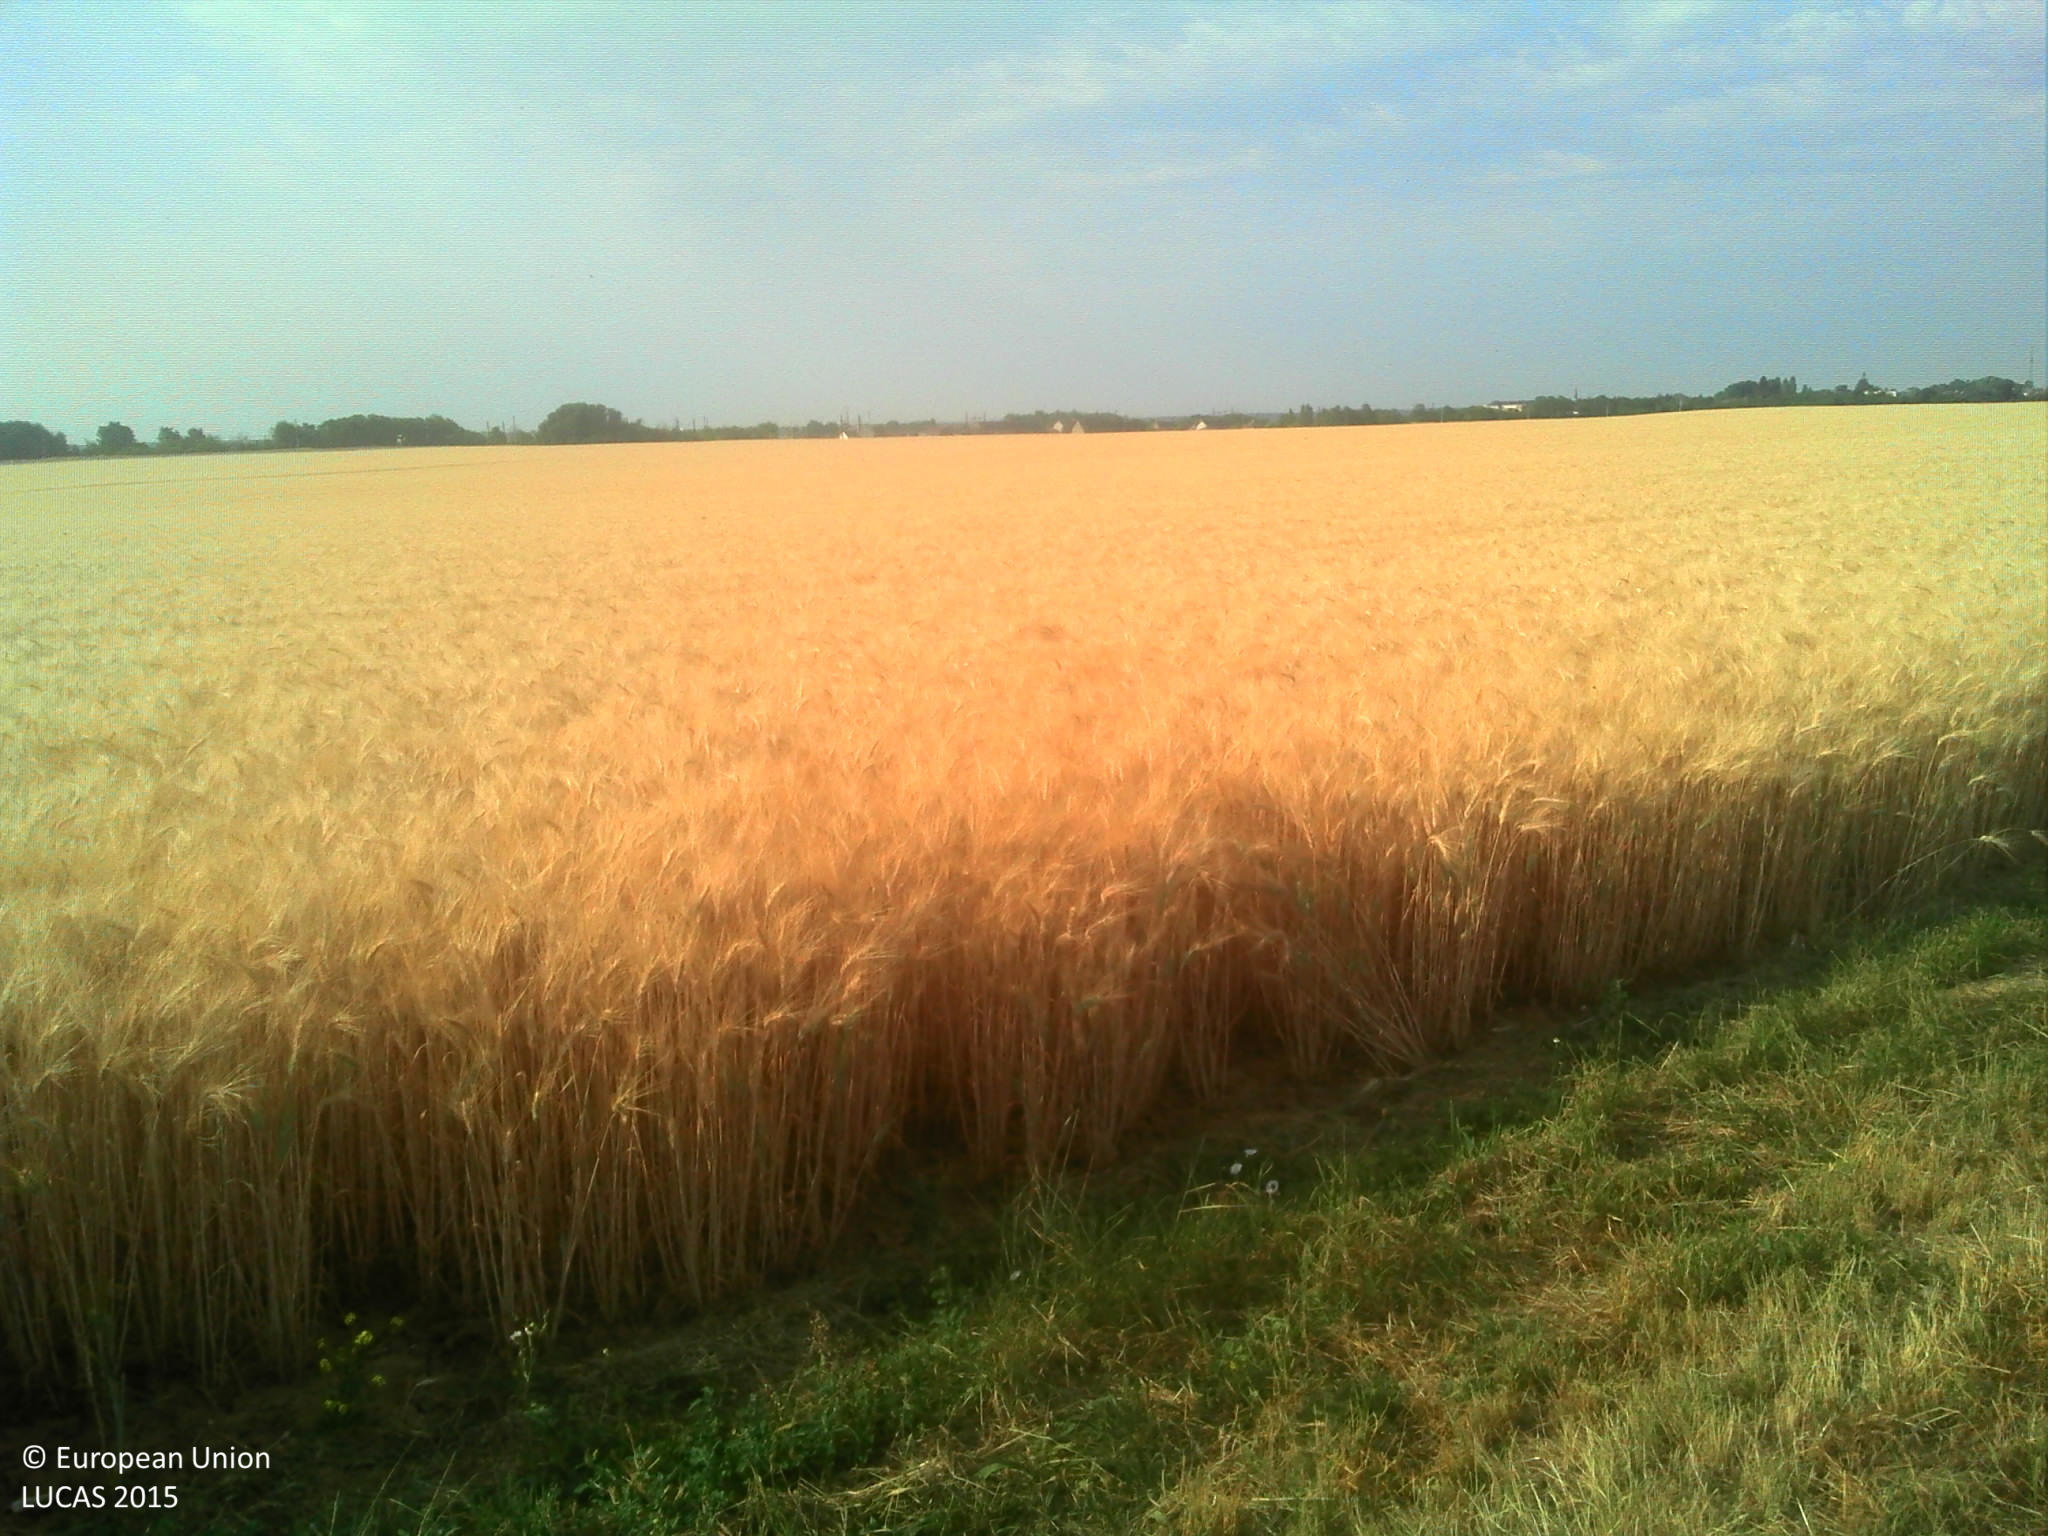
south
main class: Cropland
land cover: Durum wheat
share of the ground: > 75 %
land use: Agriculture (excluding fallow land and kitchen gardens)
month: July
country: FR
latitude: 47.6316
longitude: 1.3743
